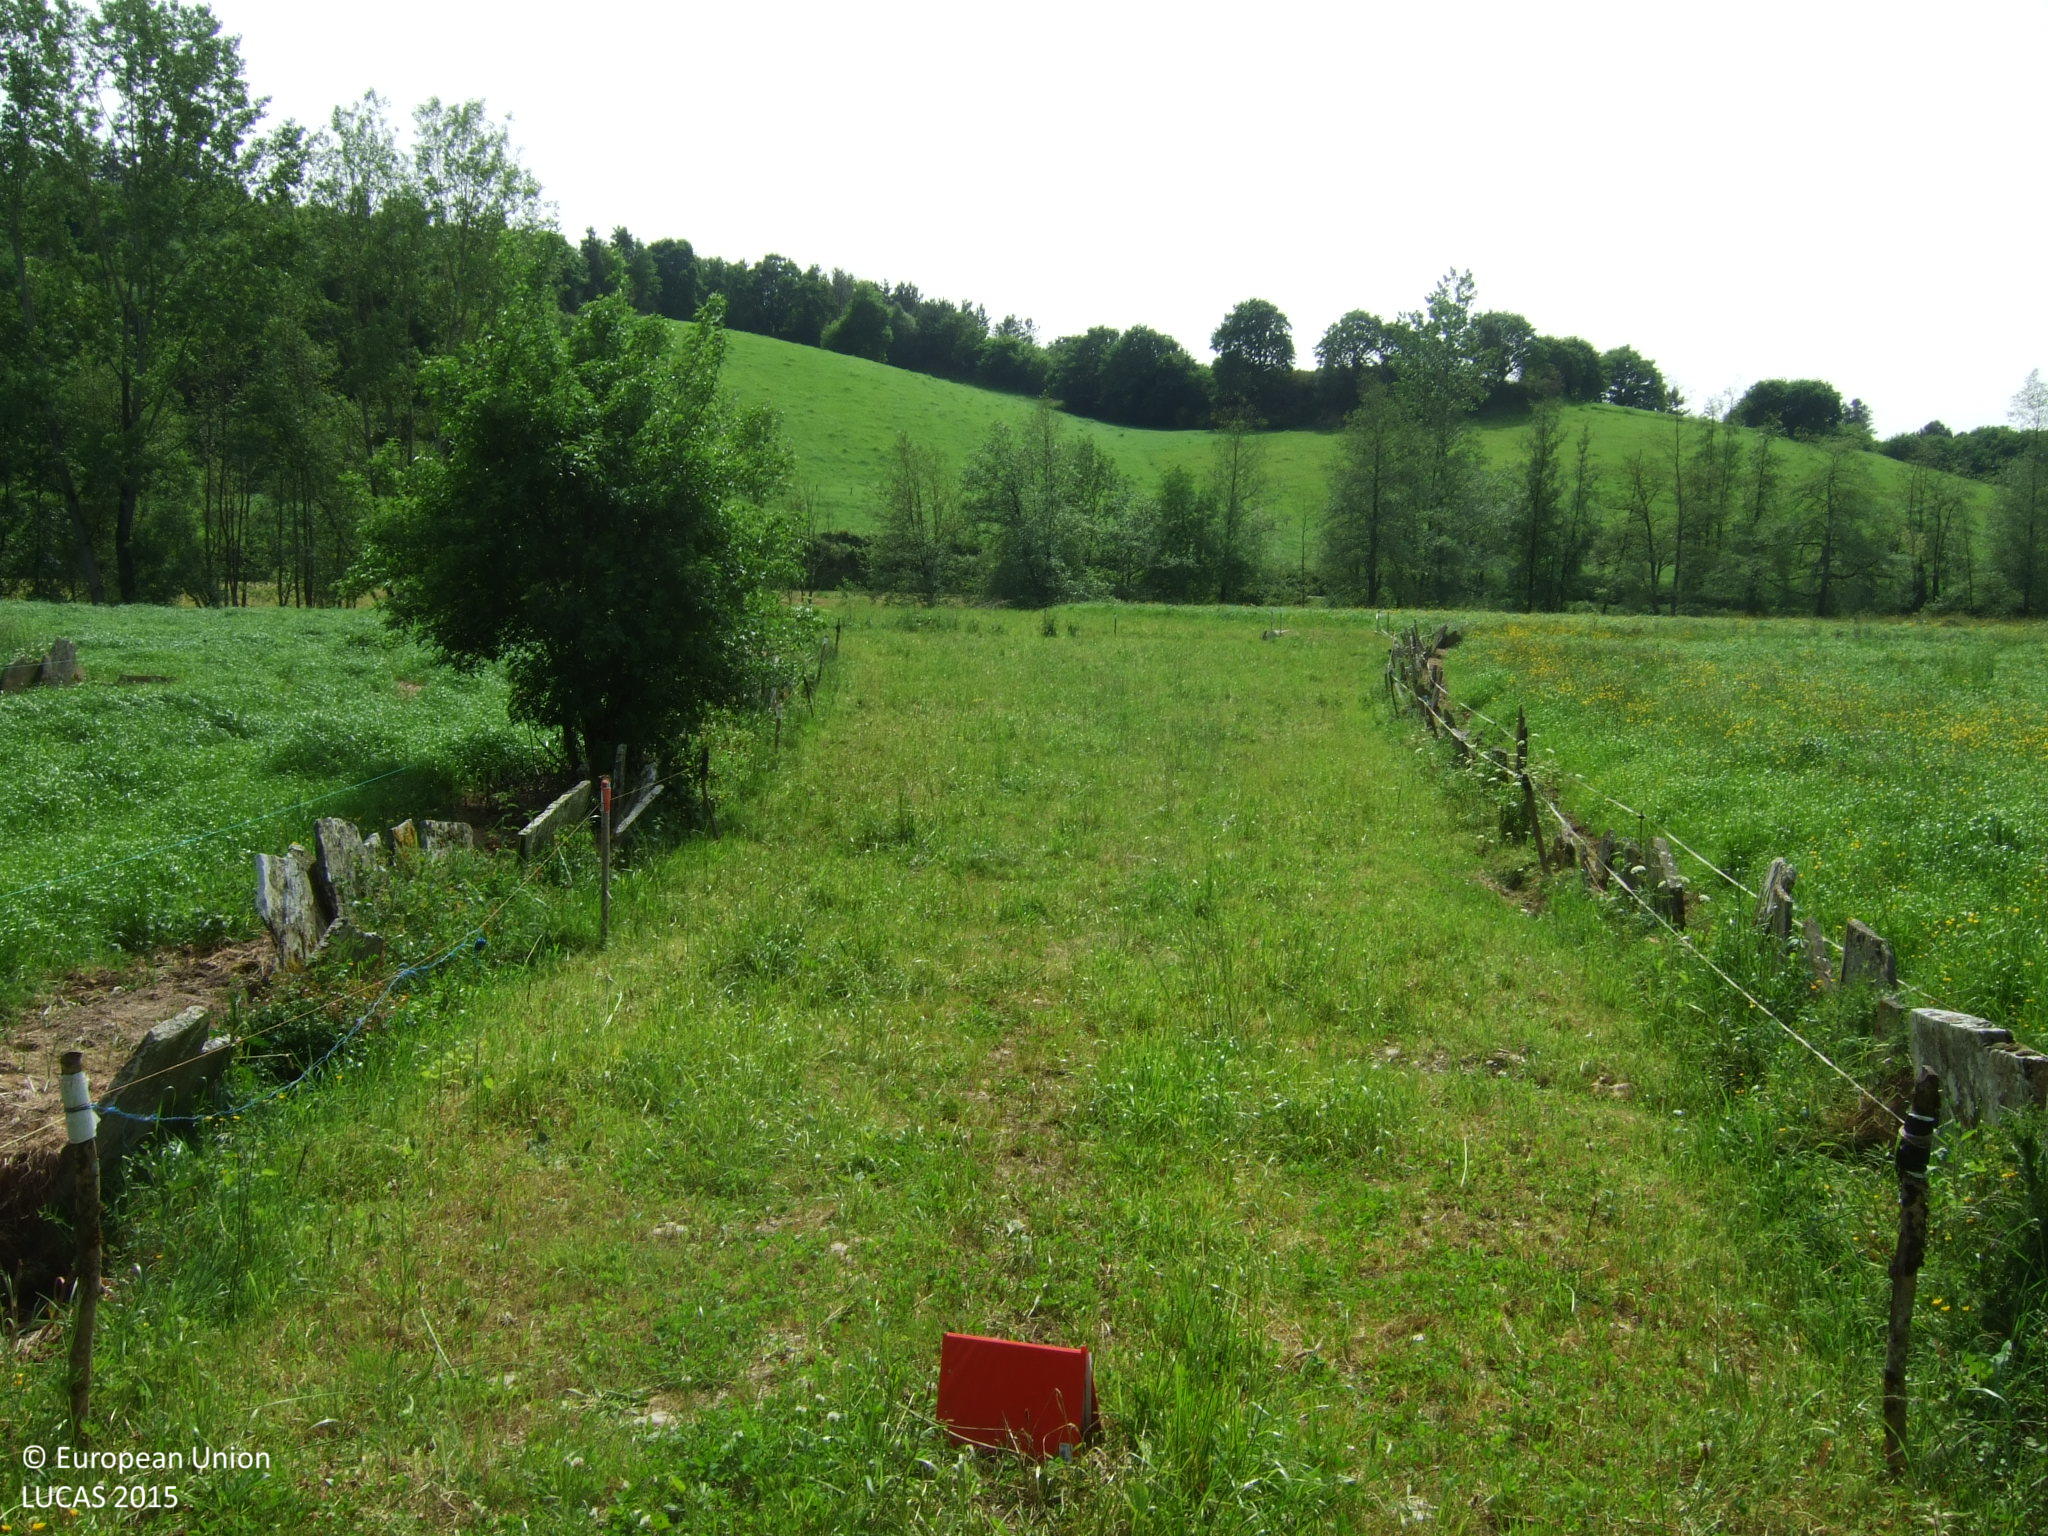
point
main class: Grassland
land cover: Grassland without tree/shrub cover
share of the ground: > 75 %
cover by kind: herbaceous plants 100 %
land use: Agriculture (excluding fallow land and kitchen gardens)
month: May
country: ES
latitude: 42.8589
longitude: -7.3382
